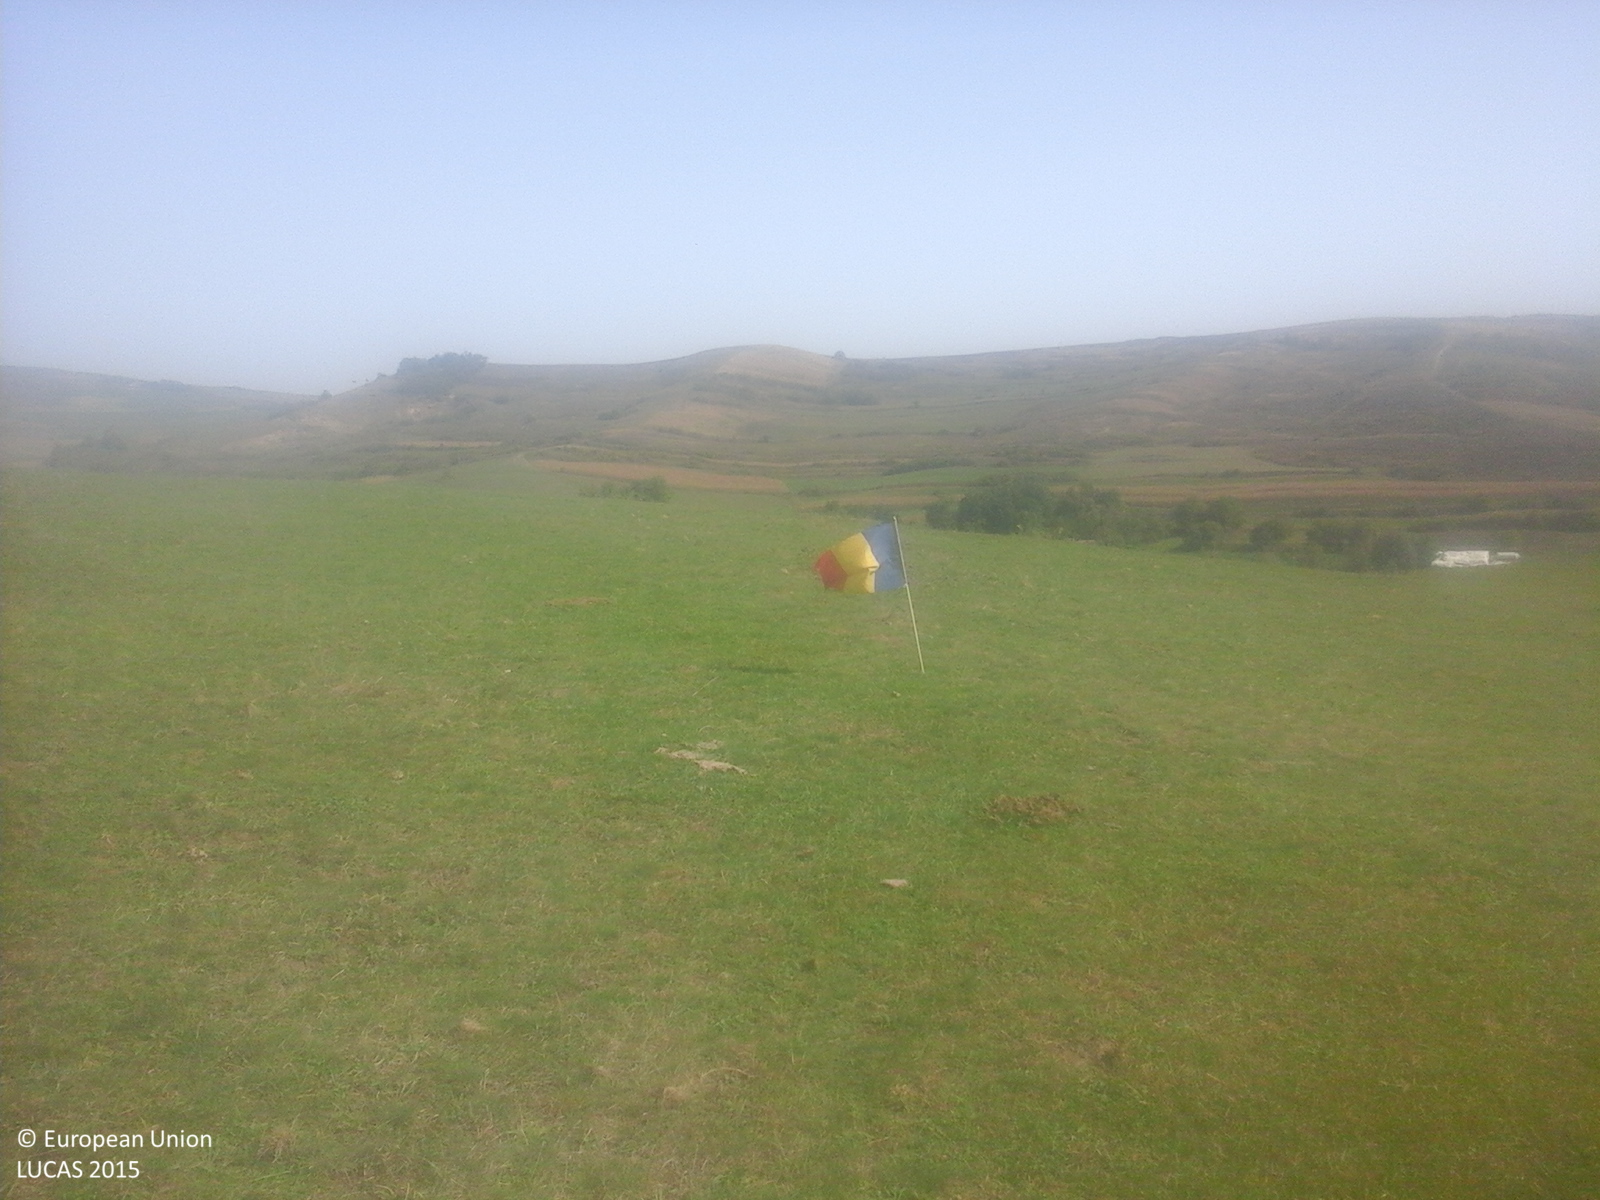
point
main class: Grassland
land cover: Grassland without tree/shrub cover
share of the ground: > 75 %
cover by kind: herbaceous plants 100 %
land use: Agriculture (excluding fallow land and kitchen gardens)
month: September
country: RO
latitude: 46.9115
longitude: 24.2245
